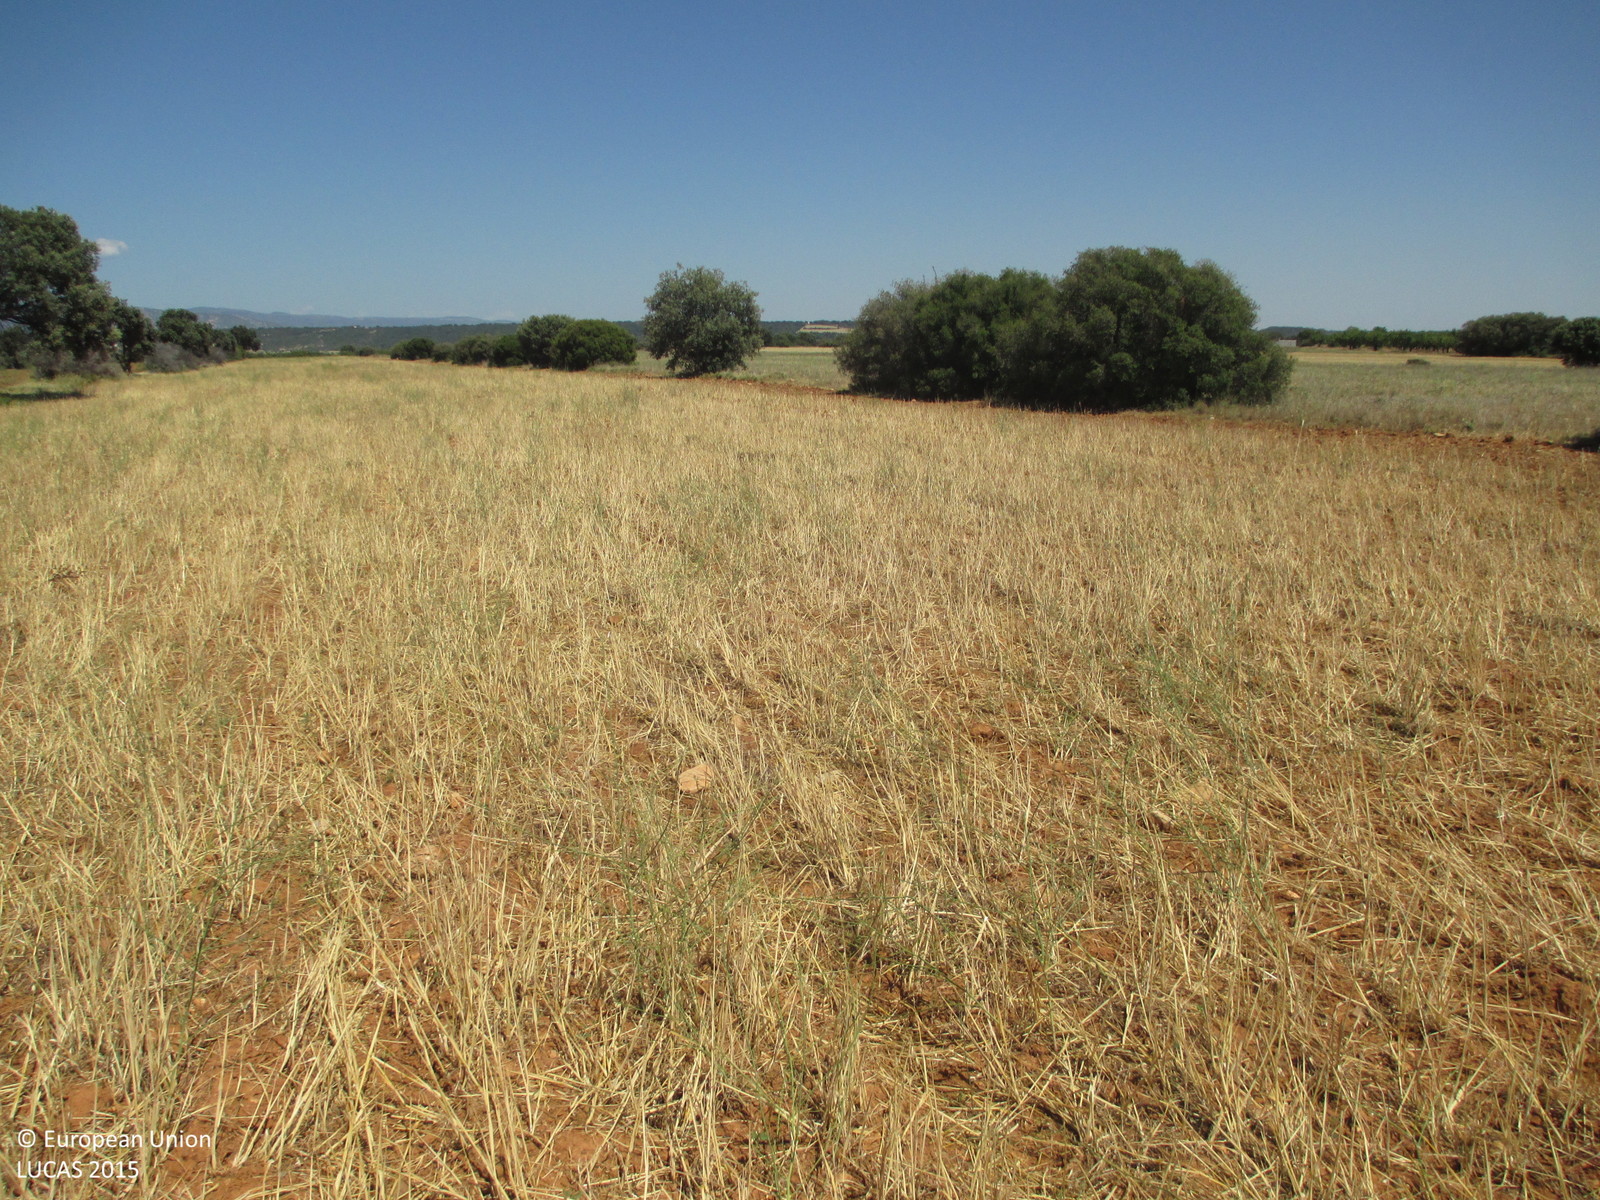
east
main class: Cropland
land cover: Barley
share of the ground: < 10 %
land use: Agriculture (excluding fallow land and kitchen gardens)
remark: Harvested field
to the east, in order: Barley; Lines of trees; Shruby margins; Grassland without tree/shrub cover
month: June
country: ES
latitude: 42.1845
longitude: -0.2774
